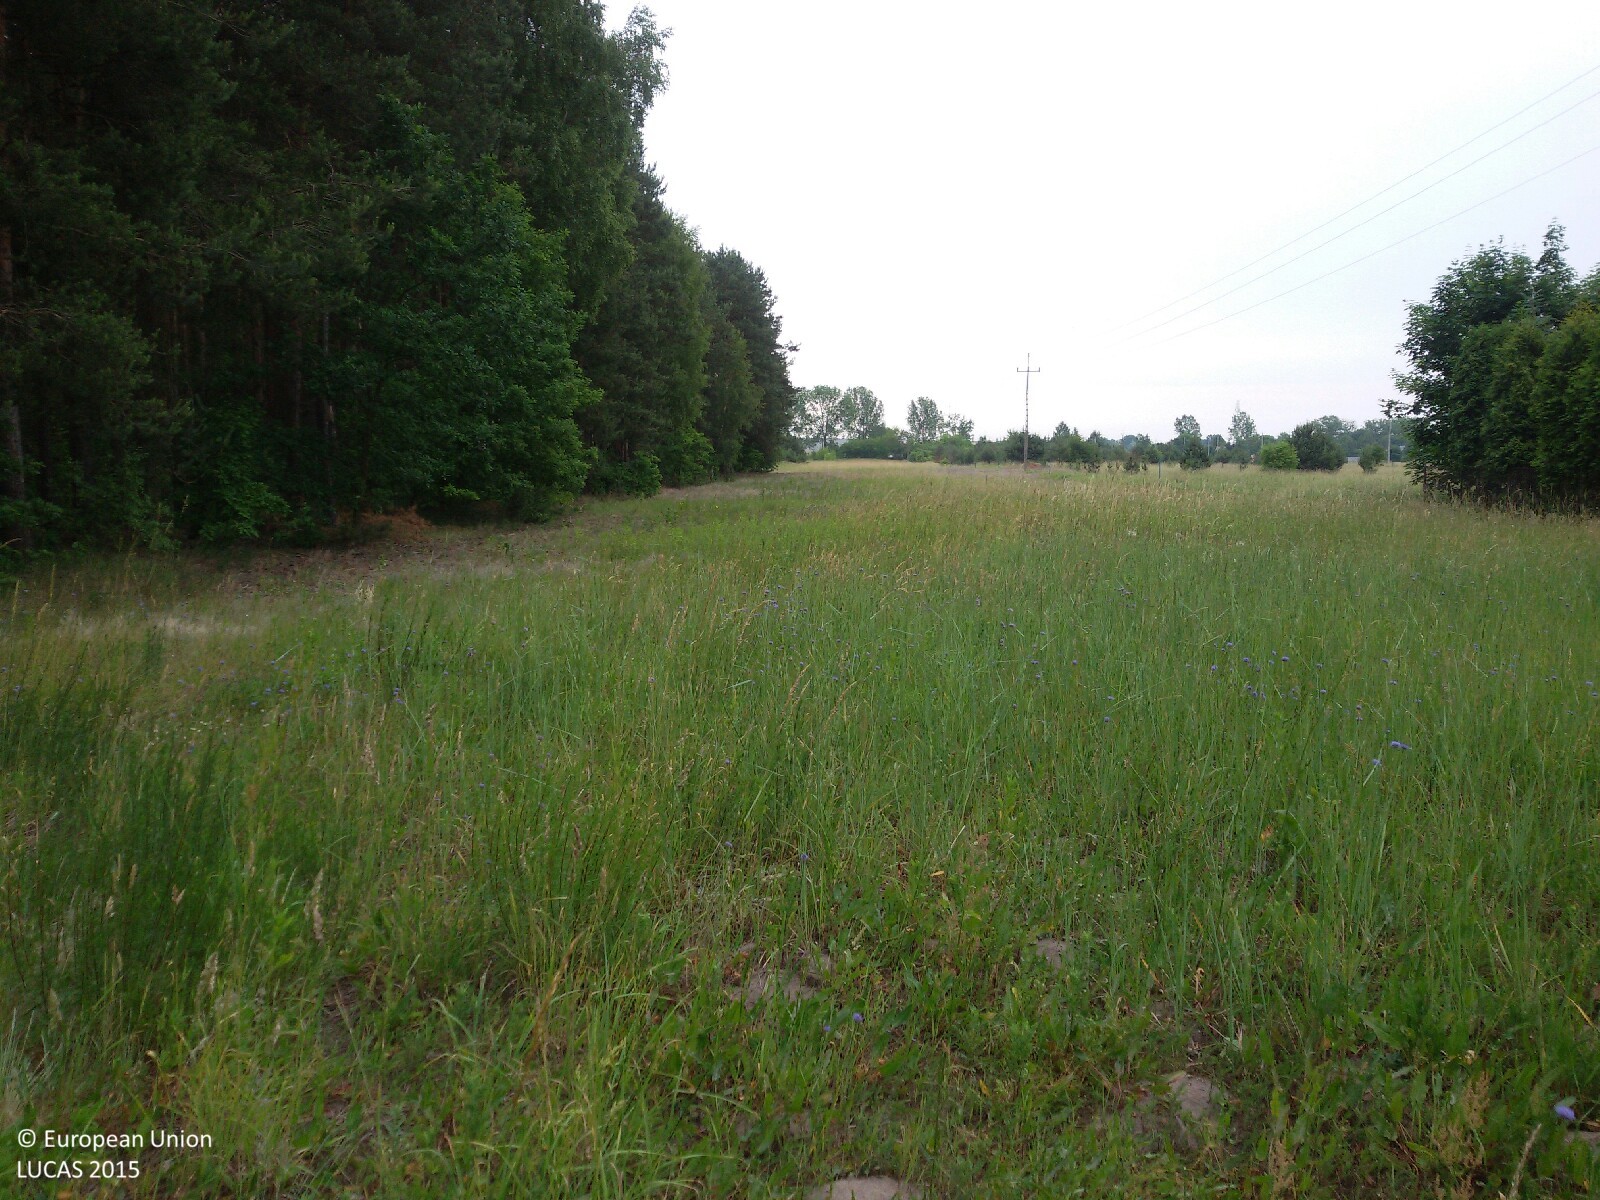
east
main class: Grassland
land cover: Grassland with sparse tree/shrub cover
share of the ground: > 75 %
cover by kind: herbaceous plants 90 %, broadleaved forest trees 5 %, shrubs 5 %
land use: Residential
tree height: < 5 m
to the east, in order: Grassland with sparse tree/shrub cover; Pine dominated mixed woodland
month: June
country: PL
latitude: 52.0357
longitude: 21.1101
